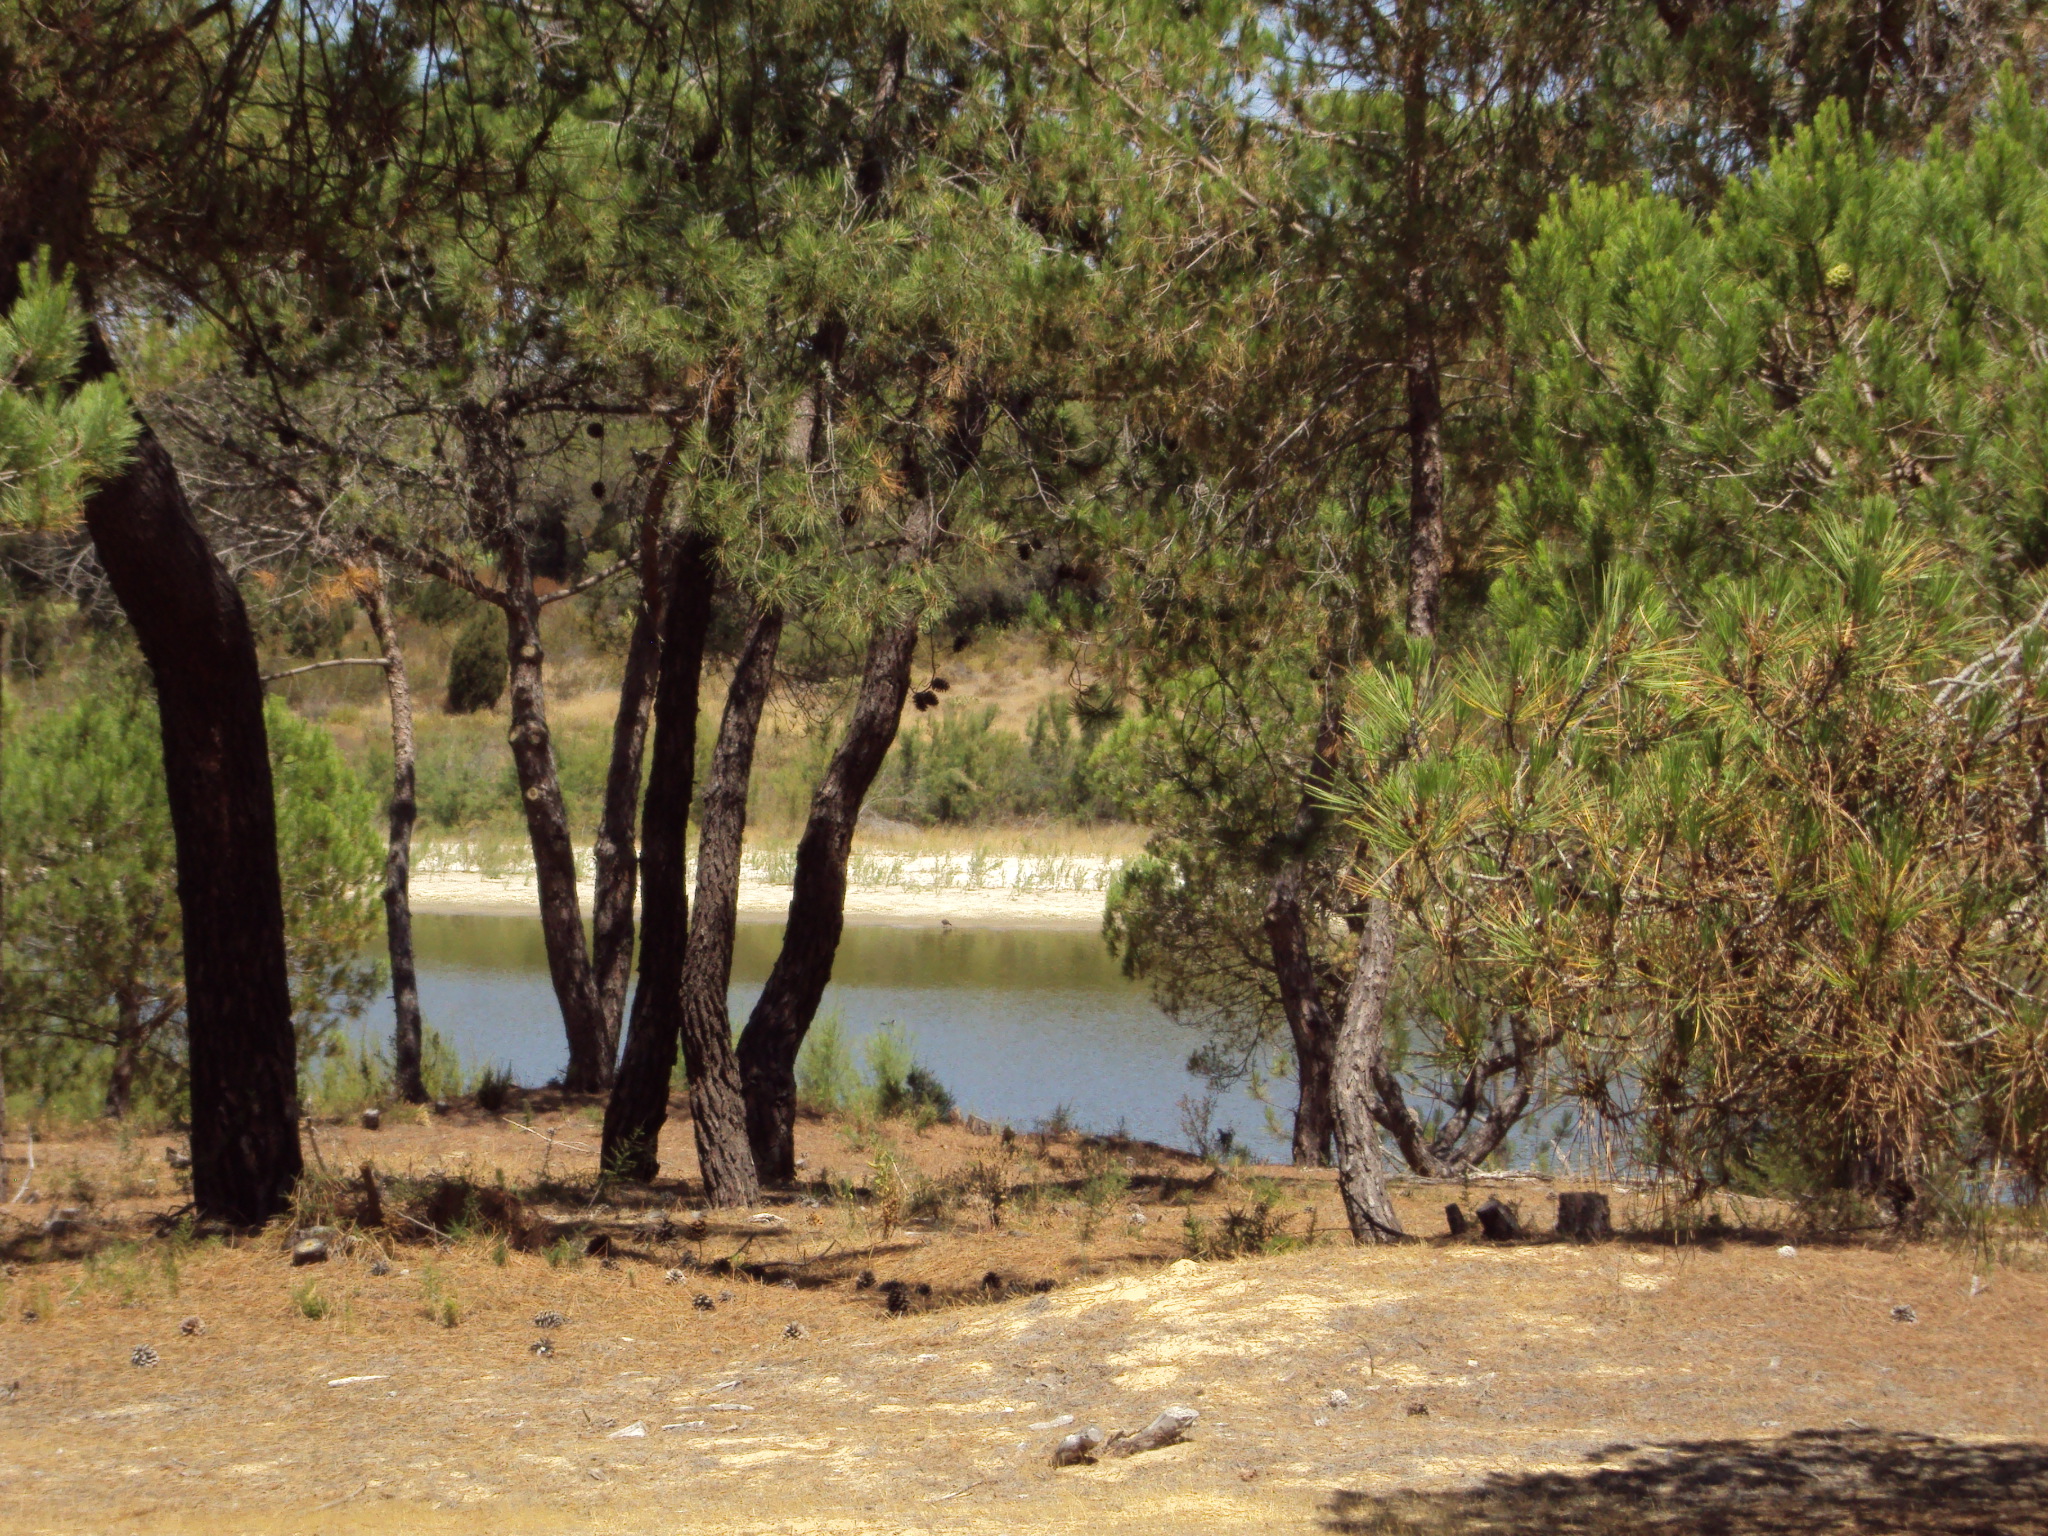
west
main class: Shrubland
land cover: Shrubland without tree cover
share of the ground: 50 - 75 %
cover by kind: shrubs 60 %, herbaceous plants 20 %, unconsolidated bare surface 20 %
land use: Semi-natural and natural areas not in use
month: July
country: ES
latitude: 37.2130
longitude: -7.0434
